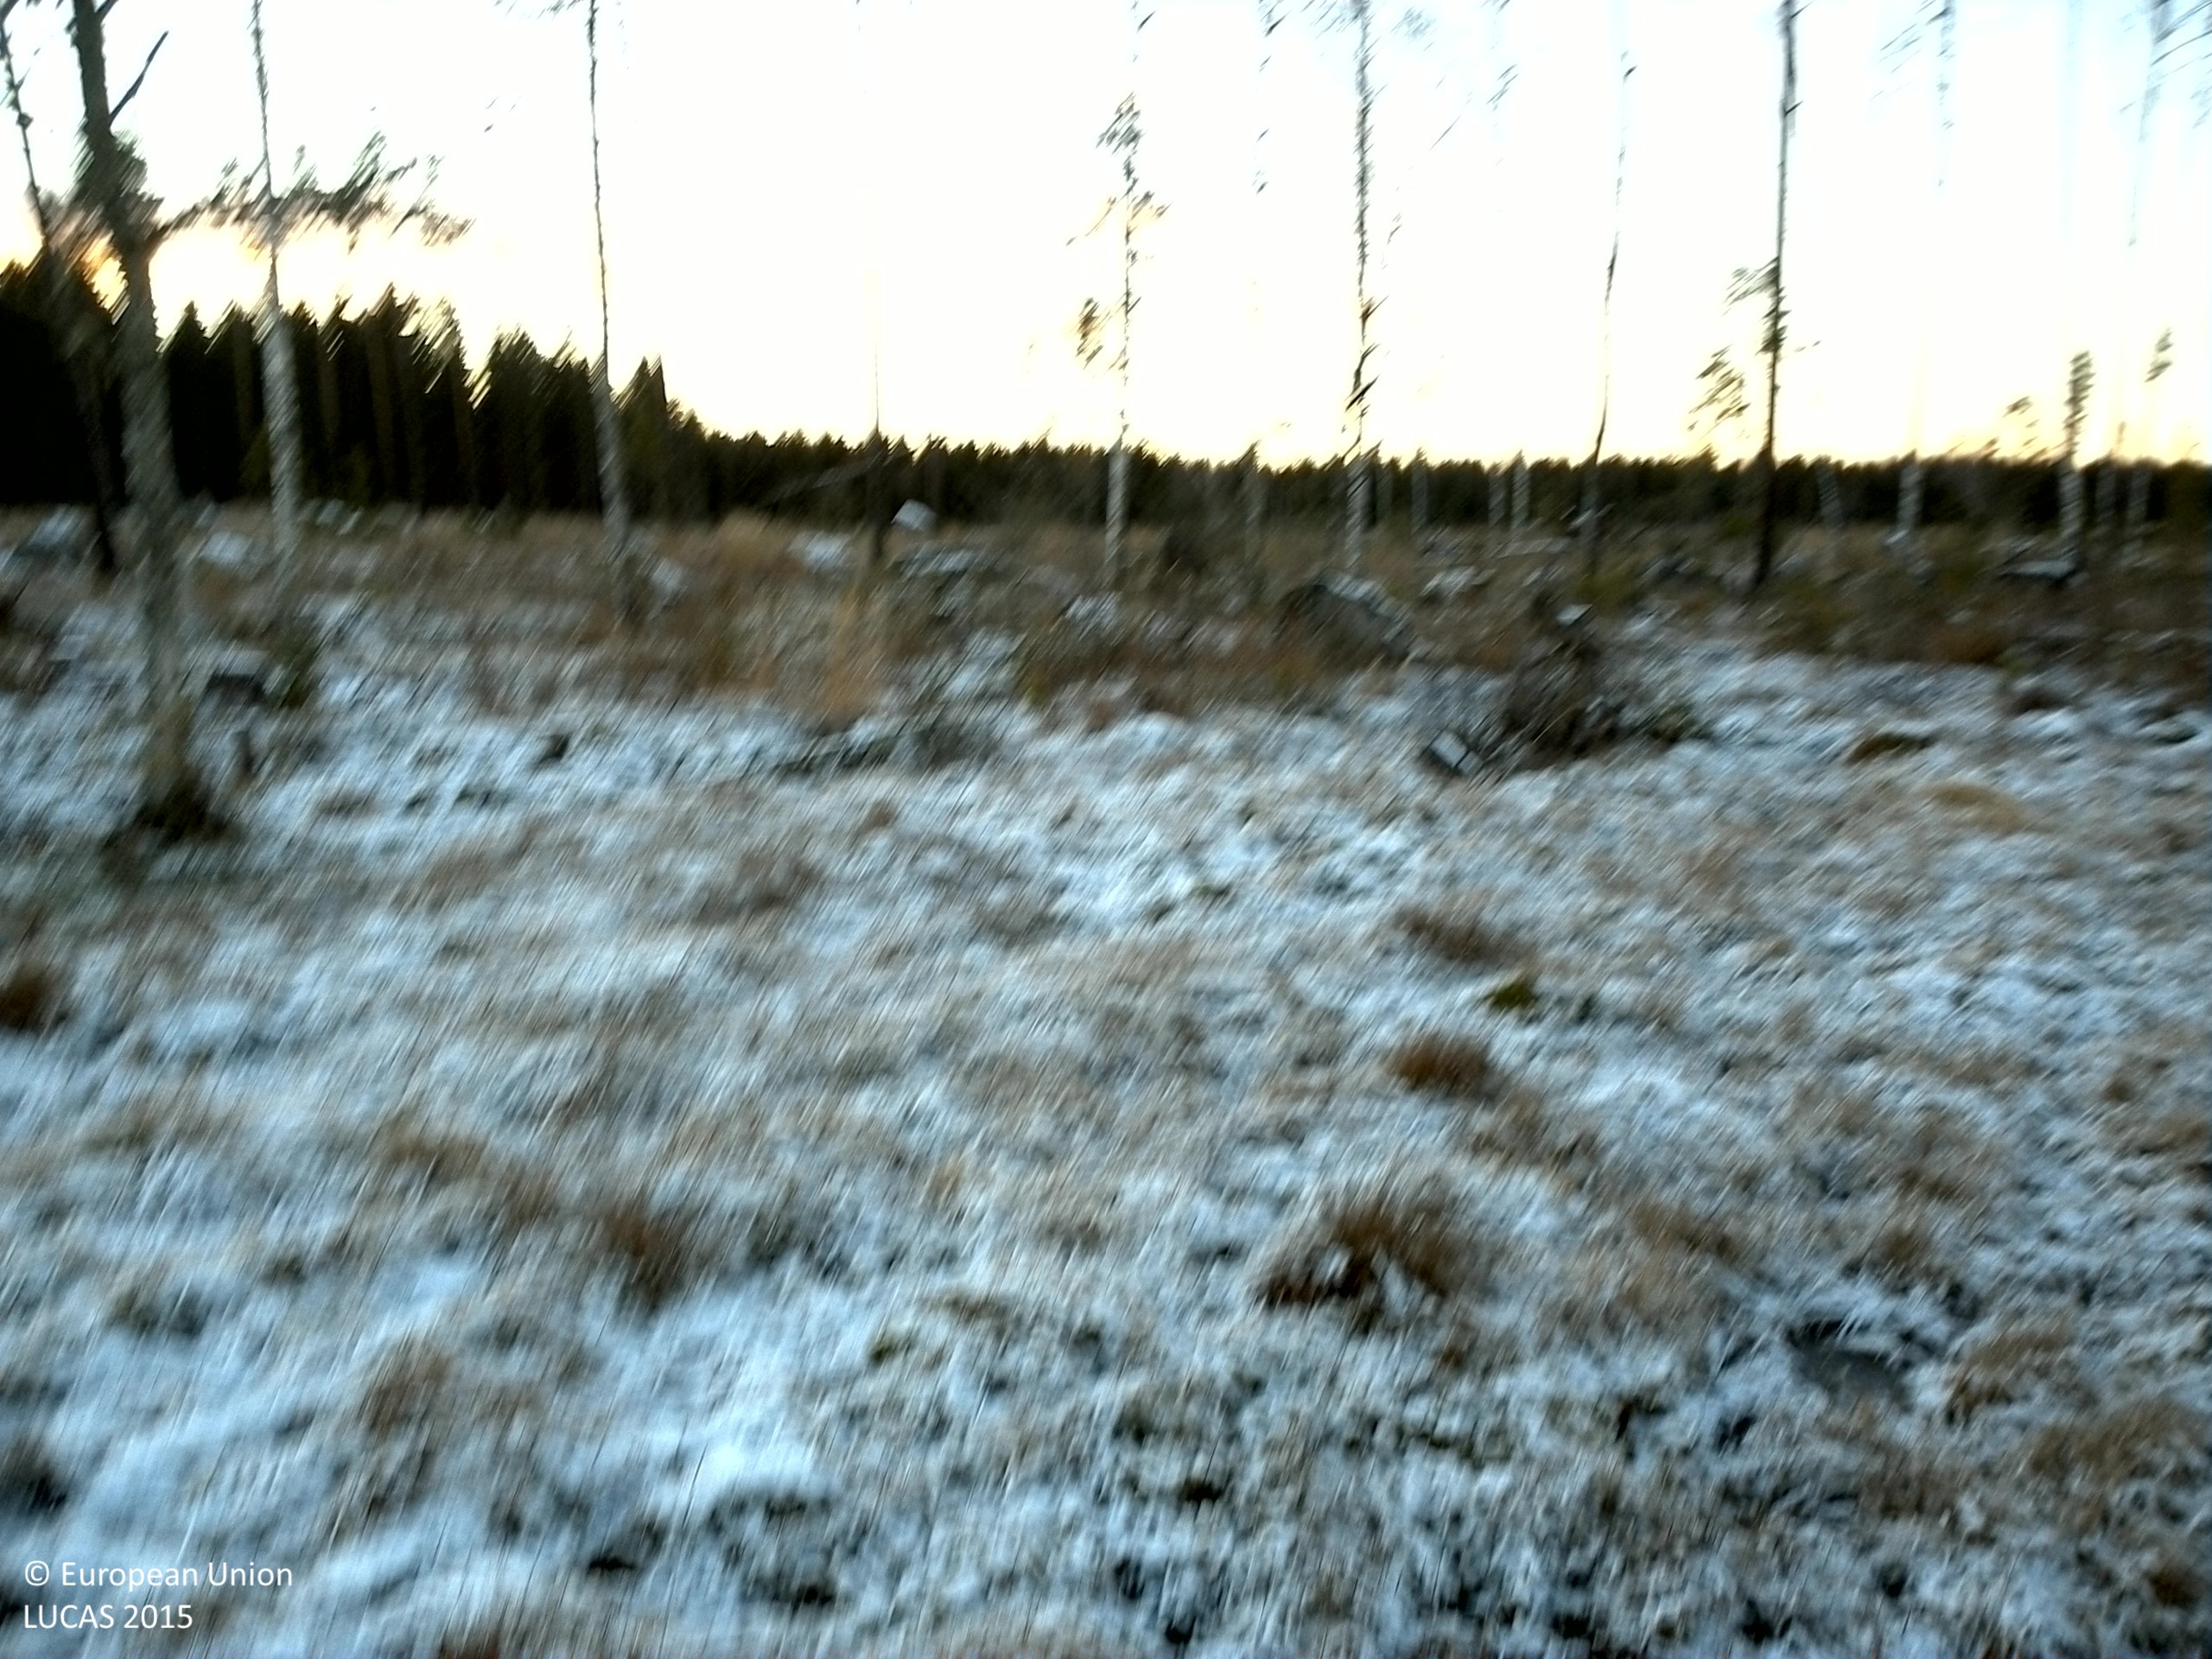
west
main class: Grassland
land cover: Grassland with sparse tree/shrub cover
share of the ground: 50 - 75 %
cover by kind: herbaceous plants 55 %, lichens and mosses 20 %, shrubs 10 %, consolidated bare surface 10 %, broadleaved forest trees 5 %
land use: Forestry
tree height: > 5 m
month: November
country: SE
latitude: 59.7652
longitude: 16.3830
